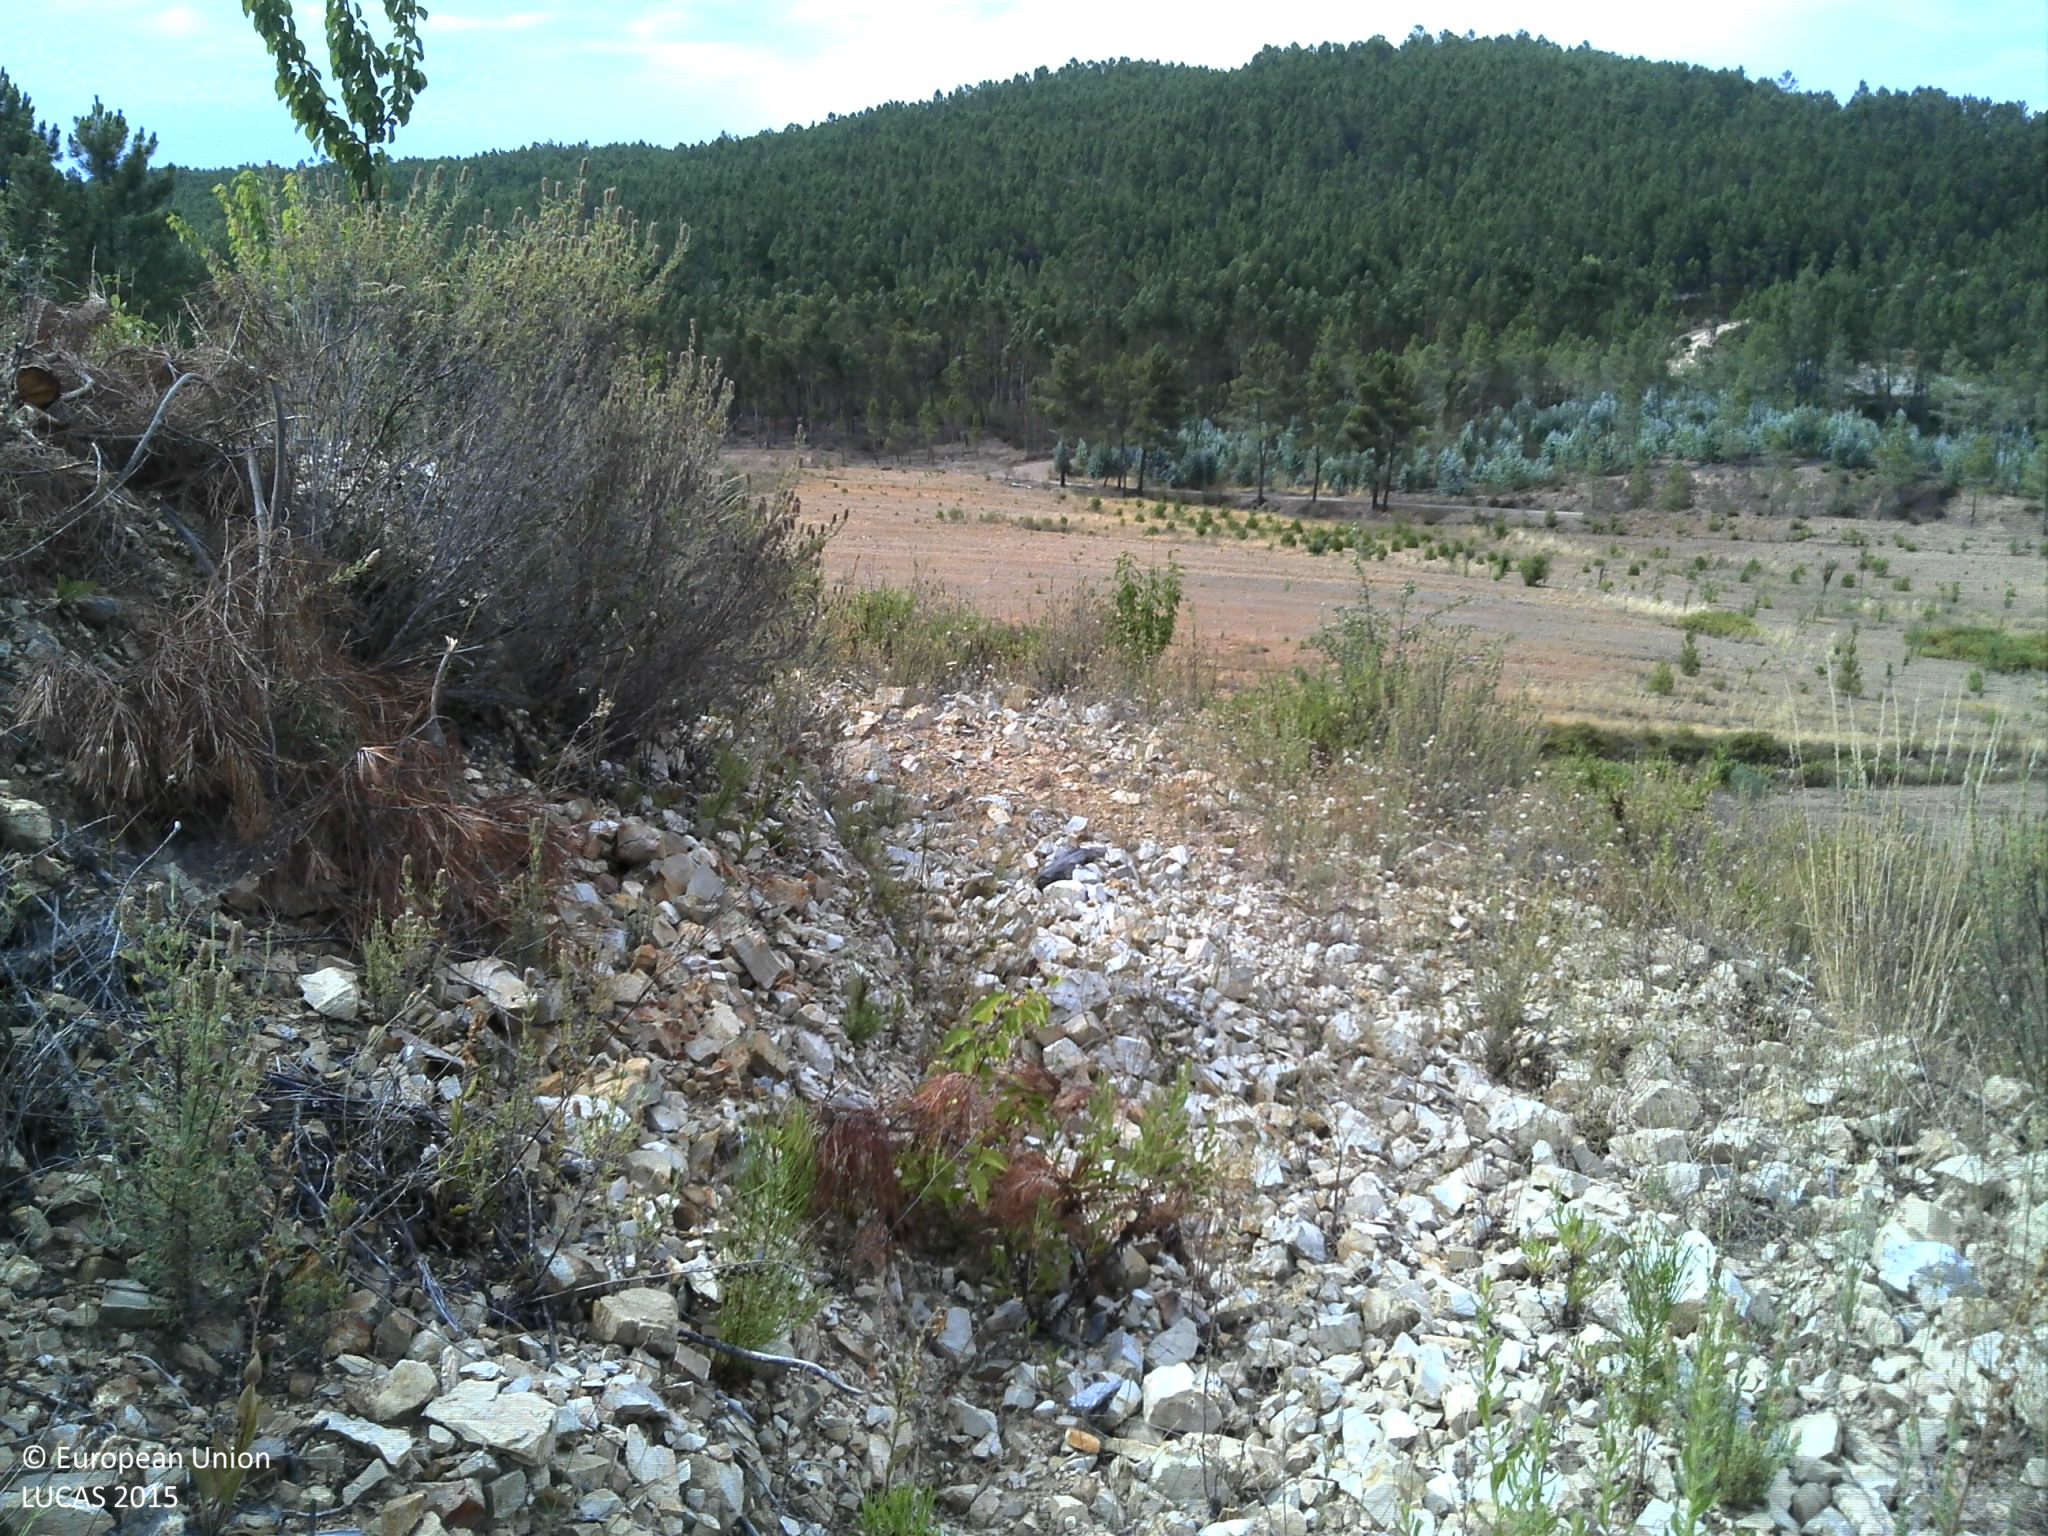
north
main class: Cropland
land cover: Cherry fruit
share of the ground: < 10 %
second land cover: Shrubland without tree cover
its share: 10 - 25 %
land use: Agriculture (excluding fallow land and kitchen gardens)
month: July
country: PT
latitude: 39.6456
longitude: -7.9723
